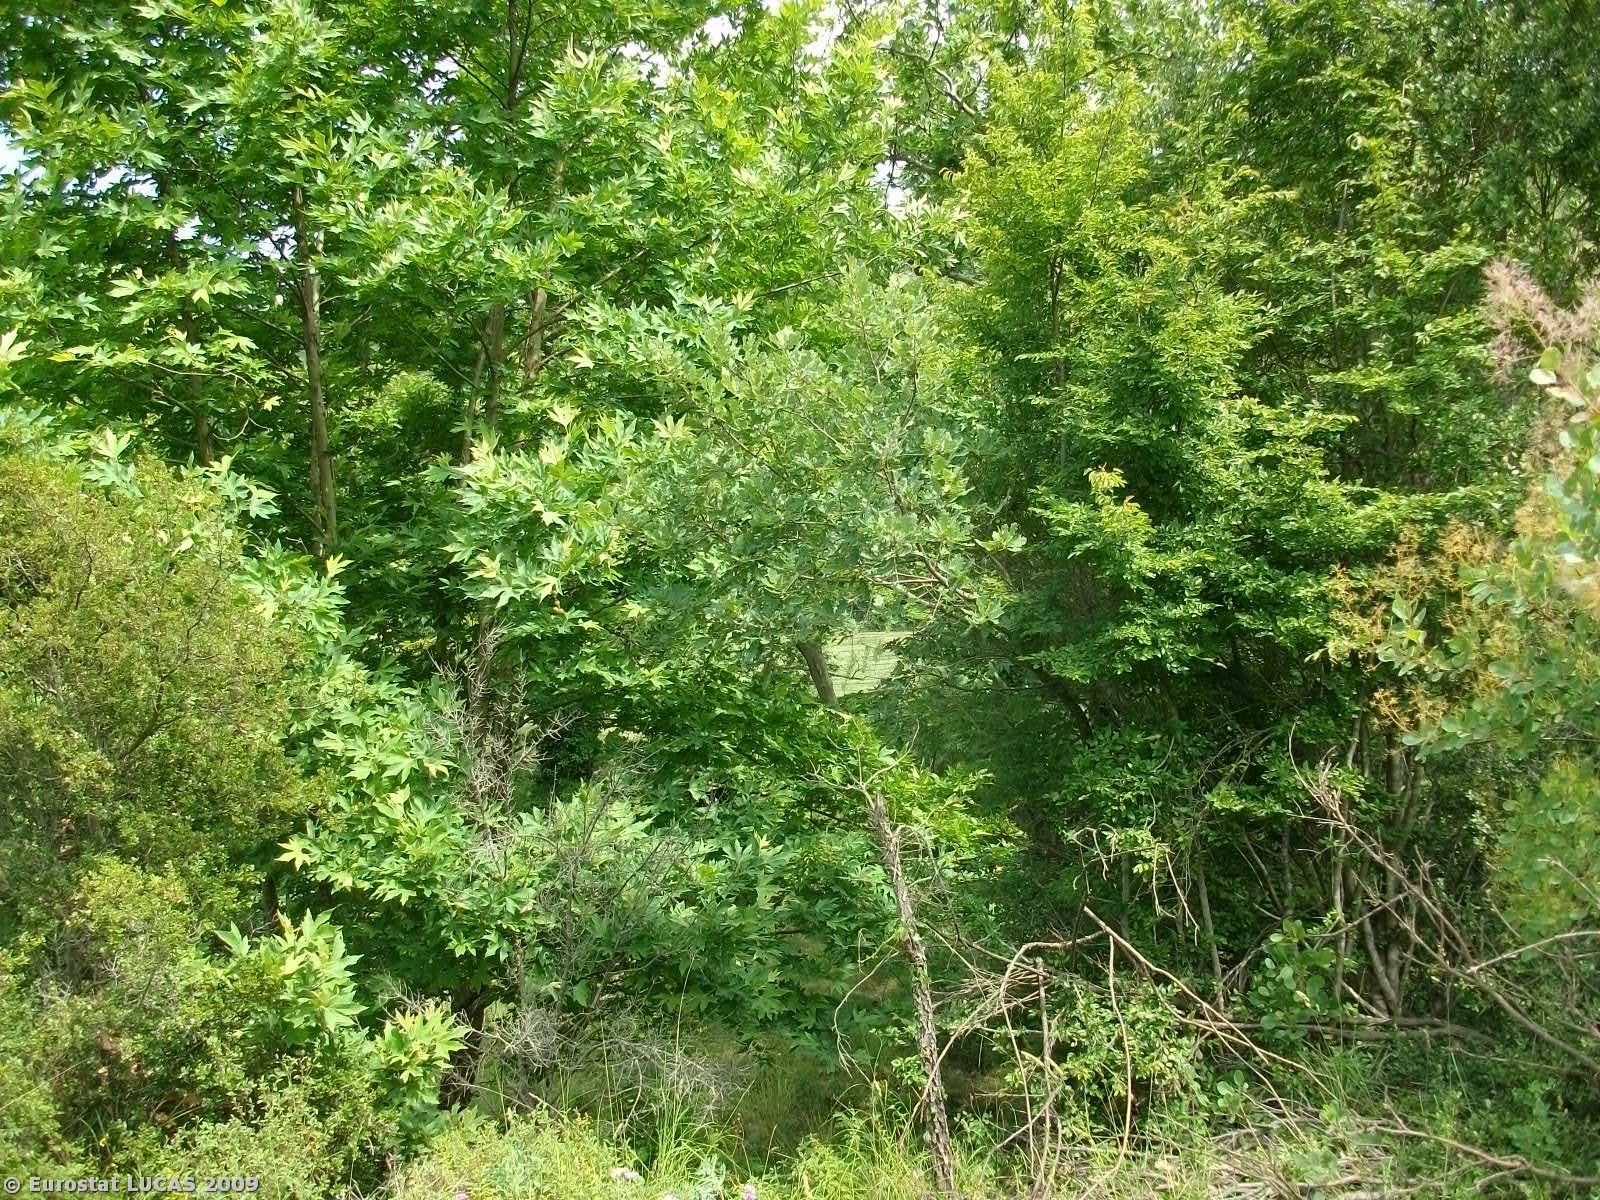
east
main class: Cropland
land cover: Olive groves
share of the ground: < 10 %
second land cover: Grassland with sparse tree/shrub cover
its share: > 75 %
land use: Agriculture (excluding fallow land and kitchen gardens)
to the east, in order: Olive groves; Grassland with sparse tree/shrub cover; Shrubland with sparse tree cover; Rivers and streams; Shrubland with sparse tree cover; Apple fruit; Broadleaved woodland
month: June
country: GR
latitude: 39.6920
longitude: 22.8569
